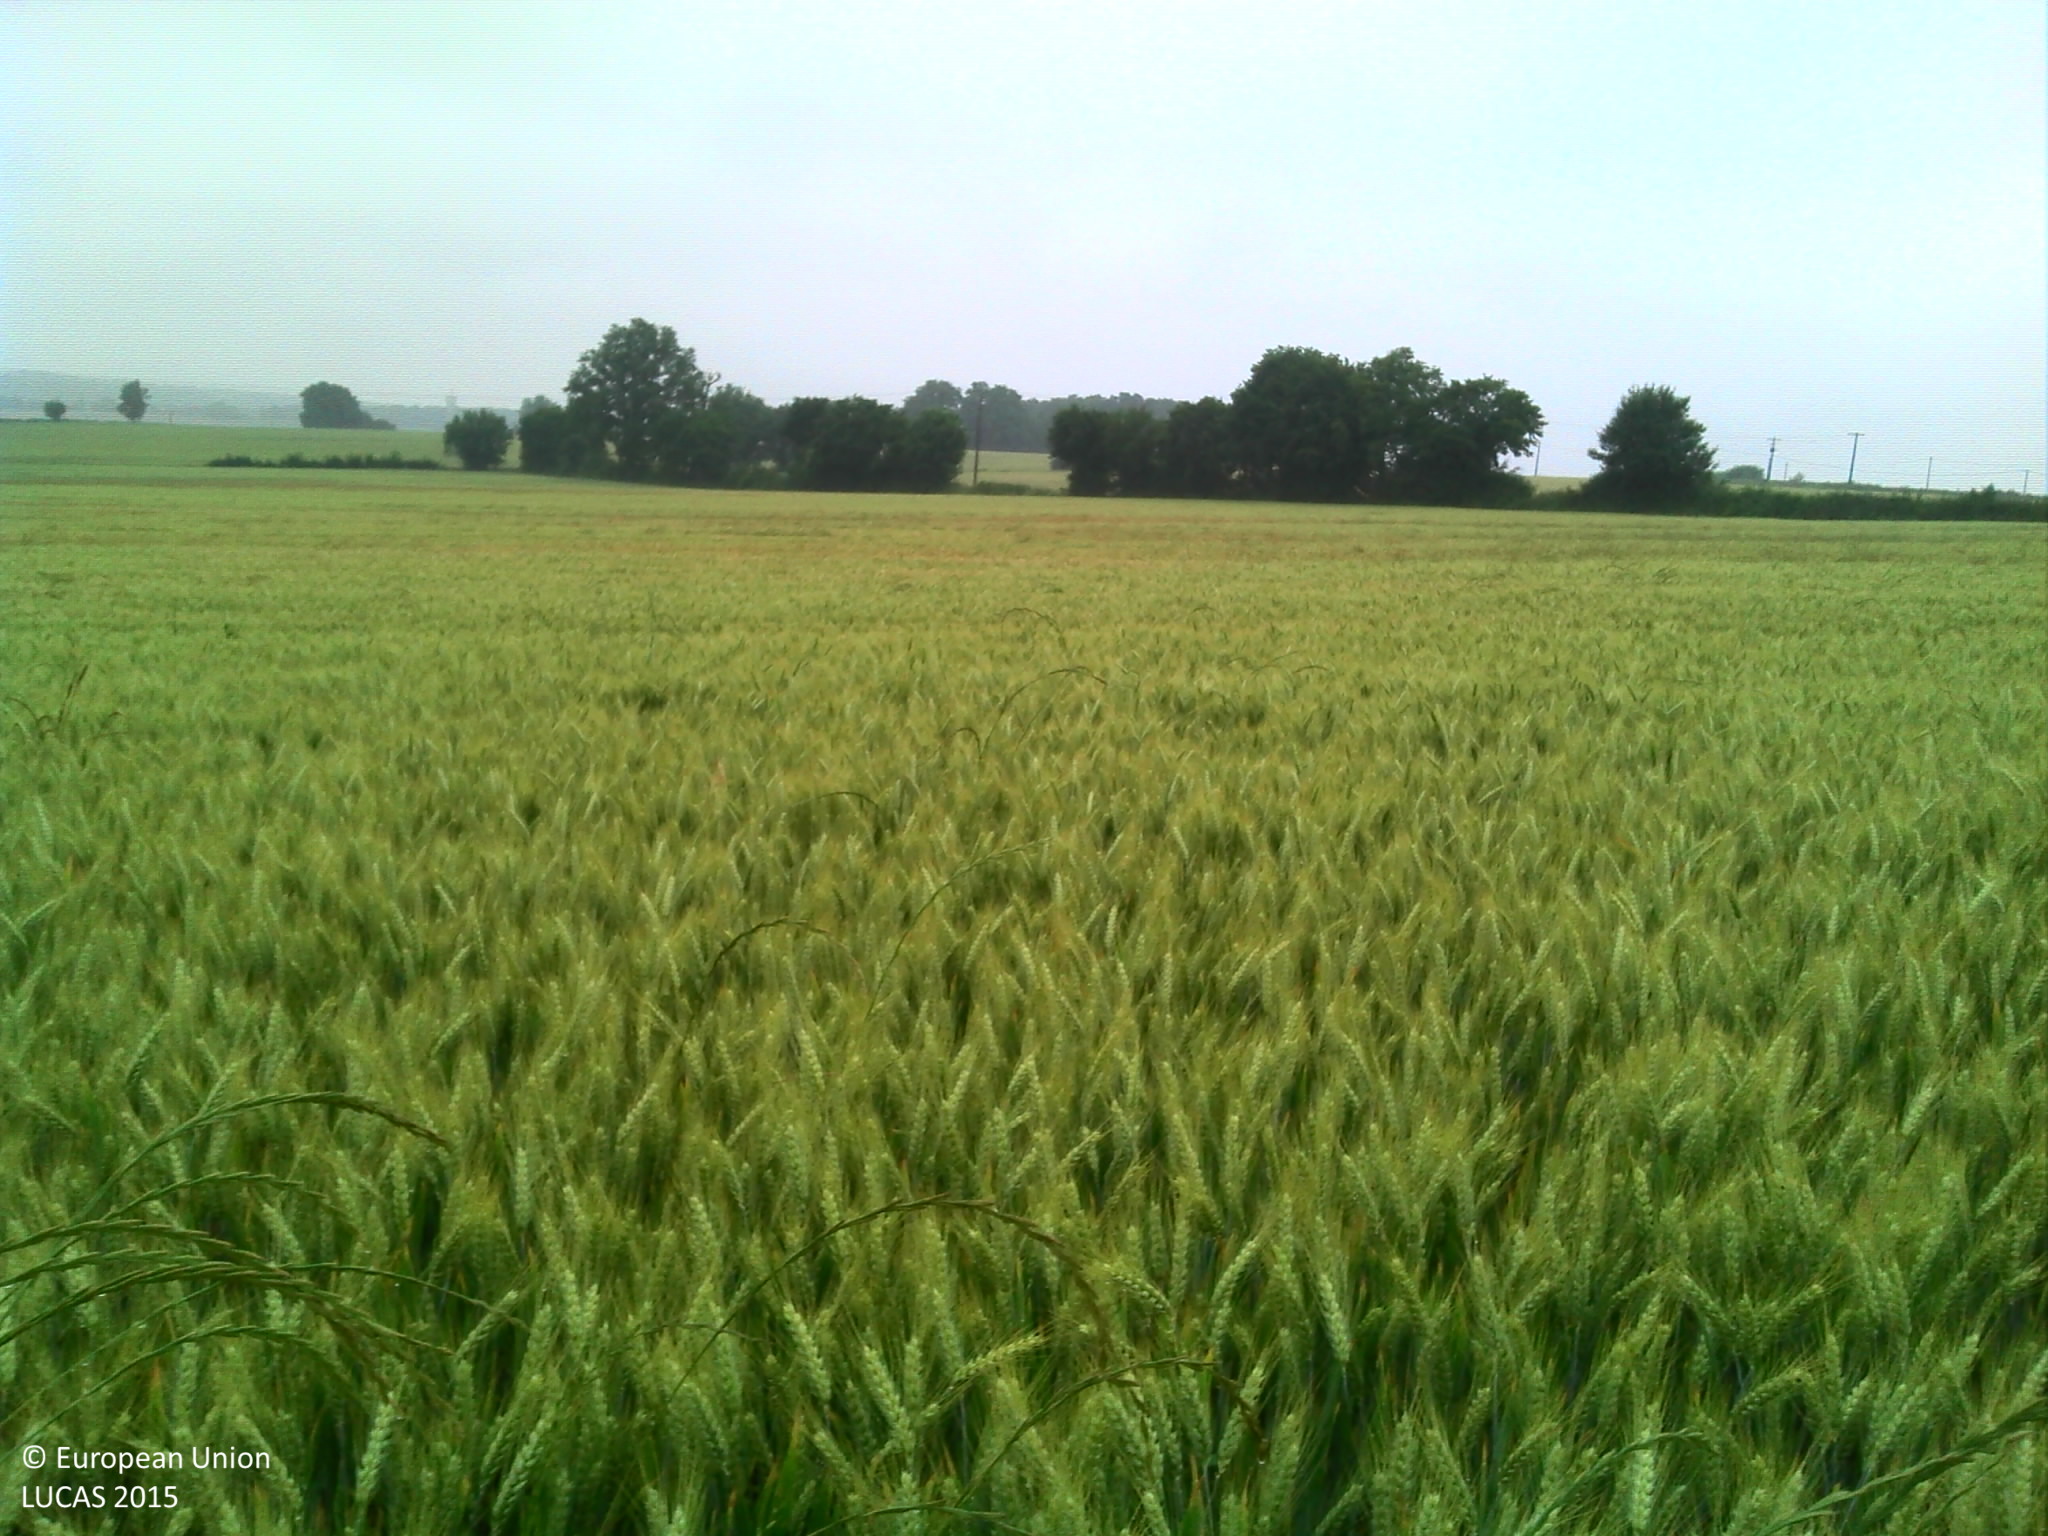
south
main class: Cropland
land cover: Common wheat
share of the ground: > 75 %
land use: Agriculture (excluding fallow land and kitchen gardens)
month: June
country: FR
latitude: 47.4724
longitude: 2.6554
